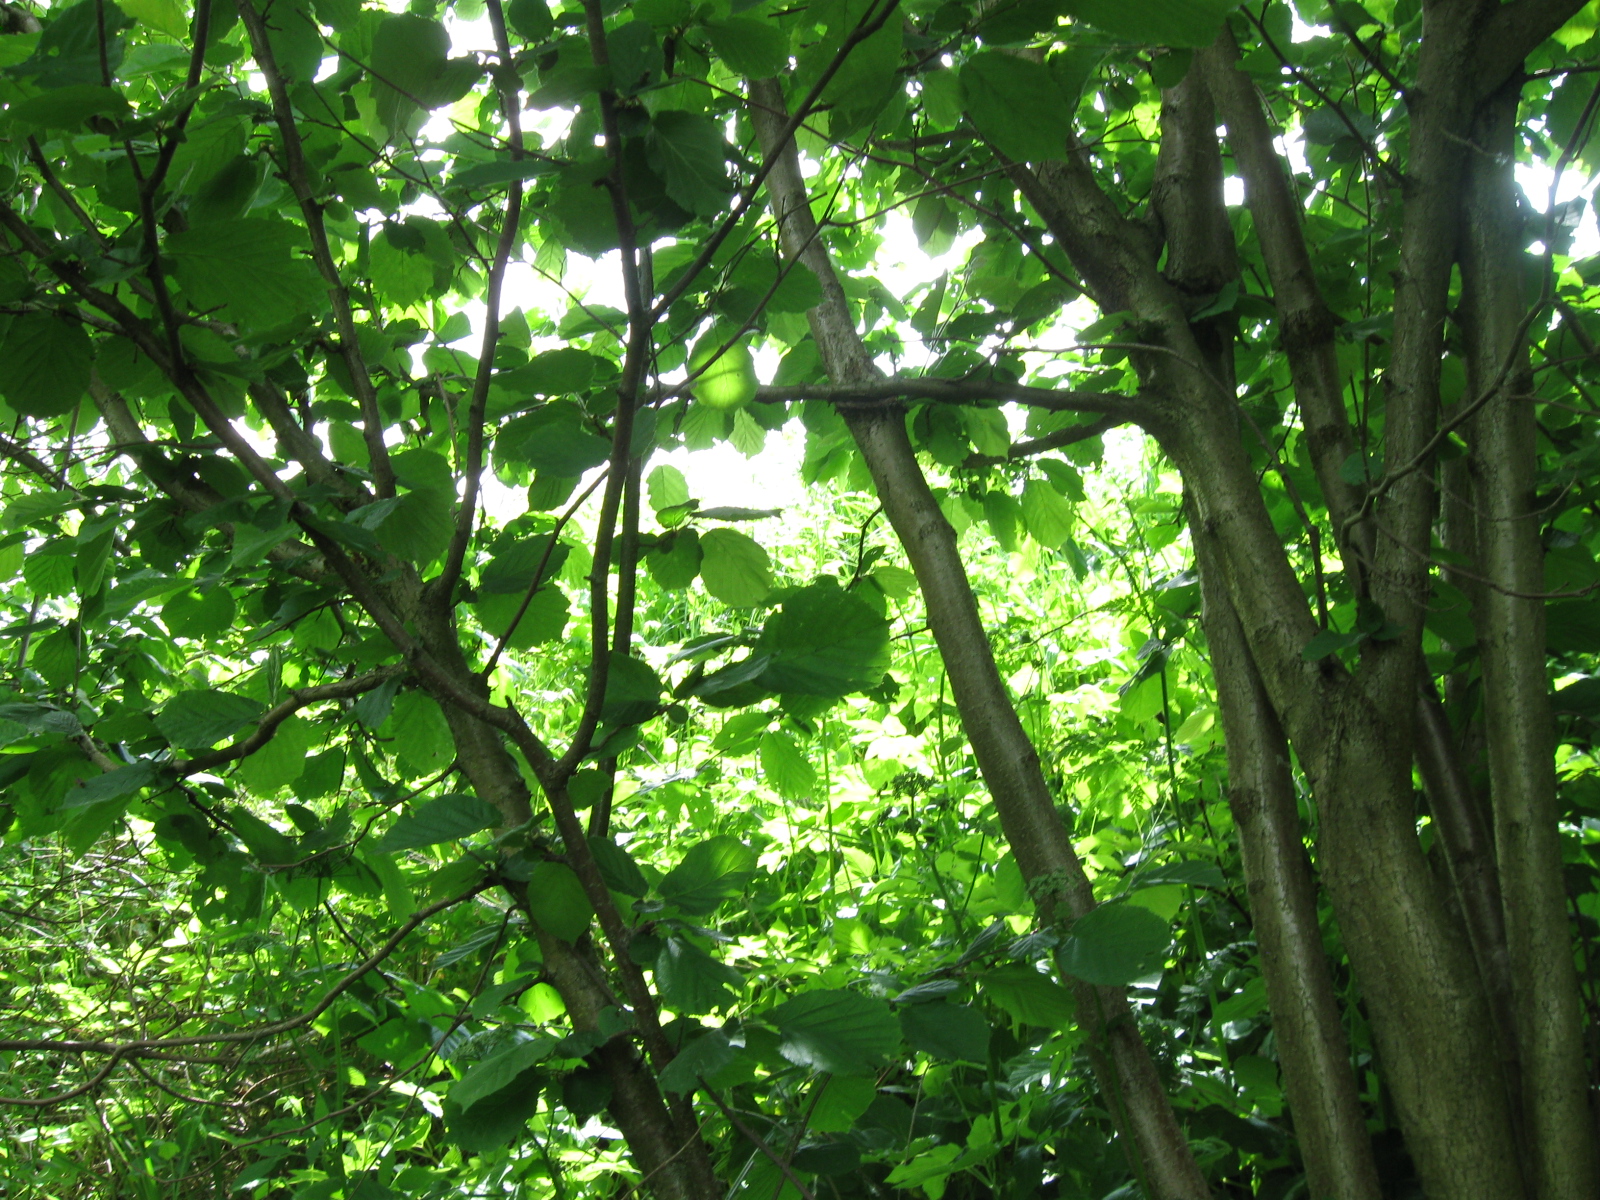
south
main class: Woodland
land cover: Broadleaved woodland
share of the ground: > 75 %
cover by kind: broadleaved forest trees 75 %, herbaceous plants 25 %
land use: Semi-natural and natural areas not in use
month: June
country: LT
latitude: 54.3488
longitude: 23.7330
